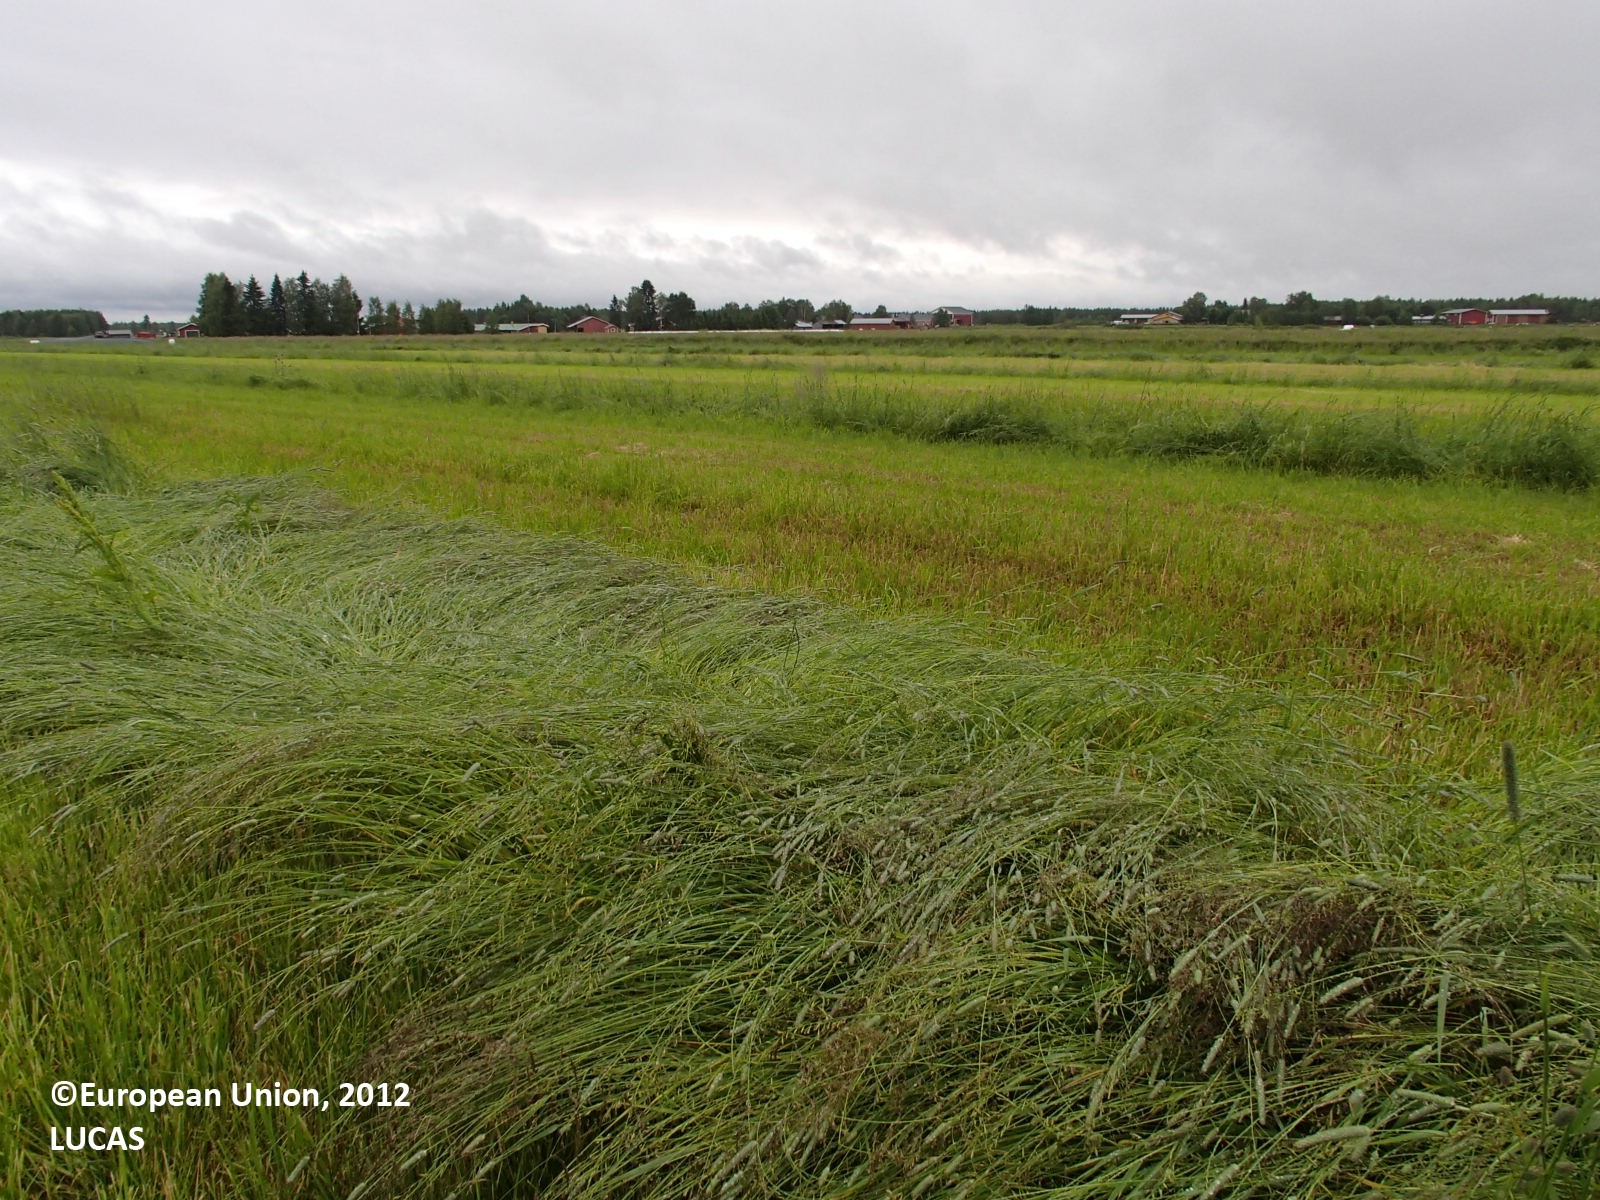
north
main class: Cropland
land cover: Temporary grasslands
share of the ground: > 75 %
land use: Agriculture (excluding fallow land and kitchen gardens)
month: July
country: FI
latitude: 64.4072
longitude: 26.4004
